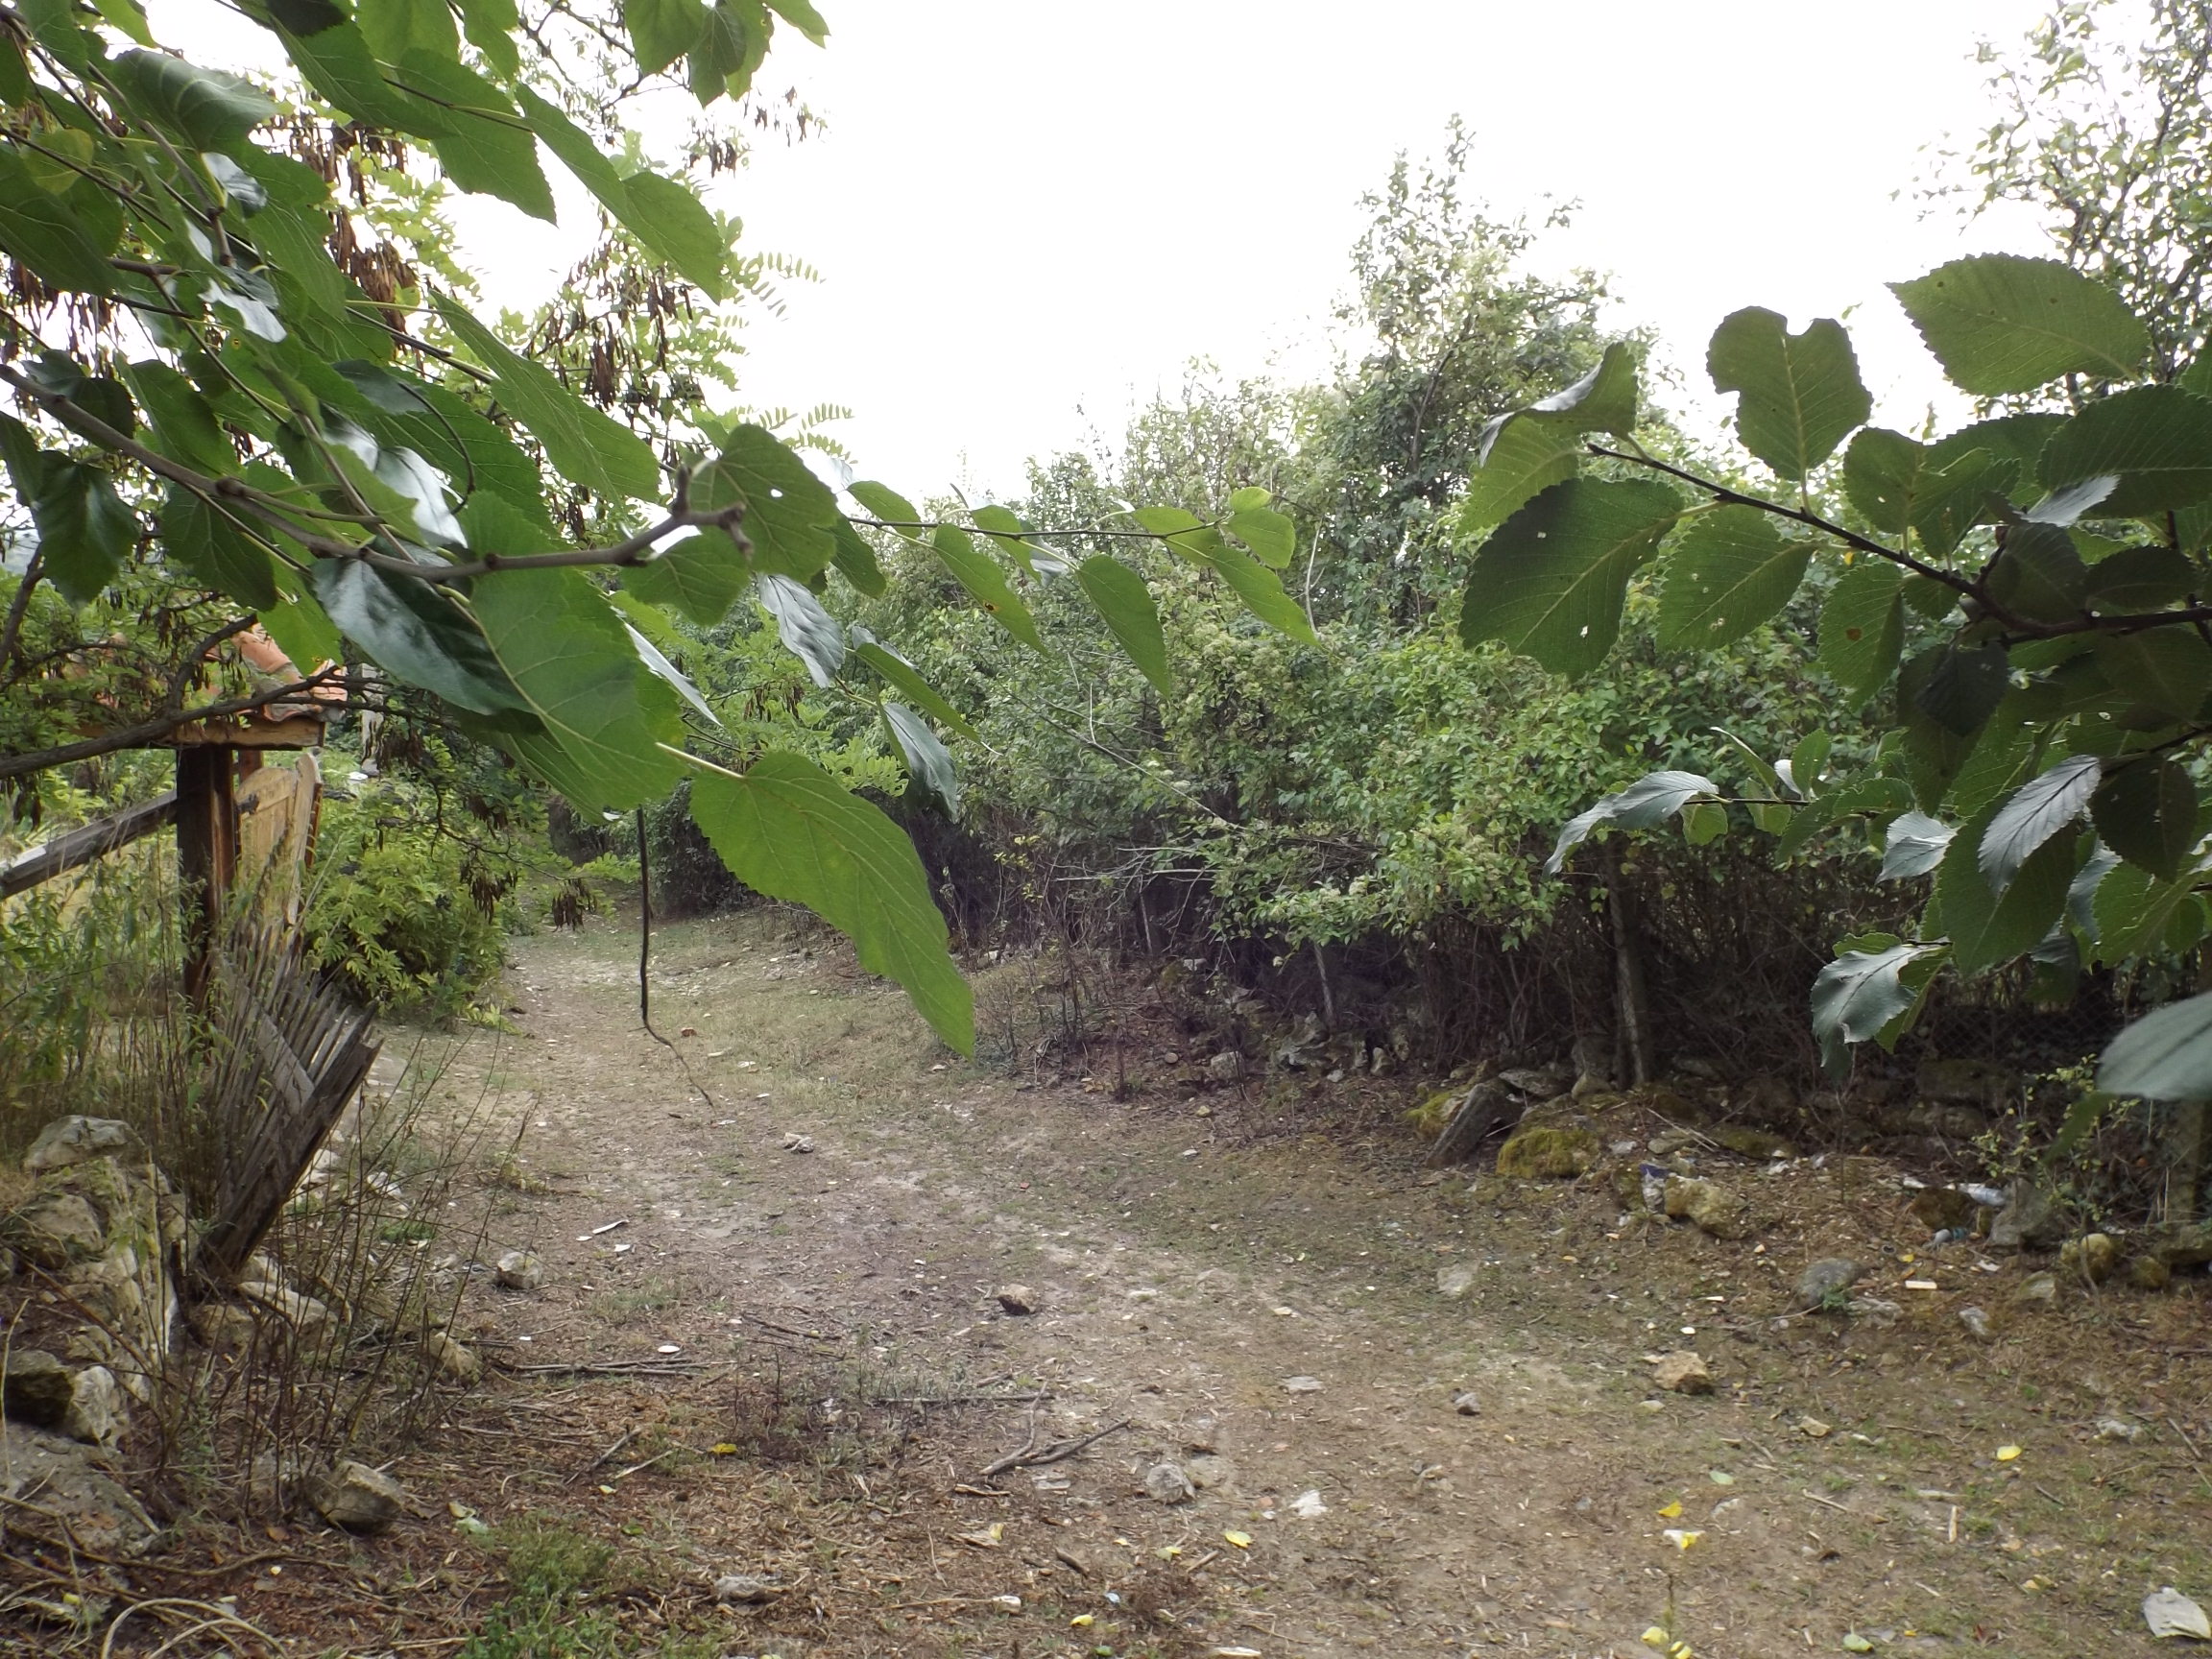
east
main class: Grassland
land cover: Grassland with sparse tree/shrub cover
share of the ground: > 75 %
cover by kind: herbaceous plants 90 %, broadleaved forest trees 5 %, shrubs 5 %
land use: Residential
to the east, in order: Fences; Grassland with sparse tree/shrub cover; Artificial constructions in urban areas; Apple fruit; Artificial constructions in urban areas
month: August
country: BG
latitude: 43.1790
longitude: 27.5107
